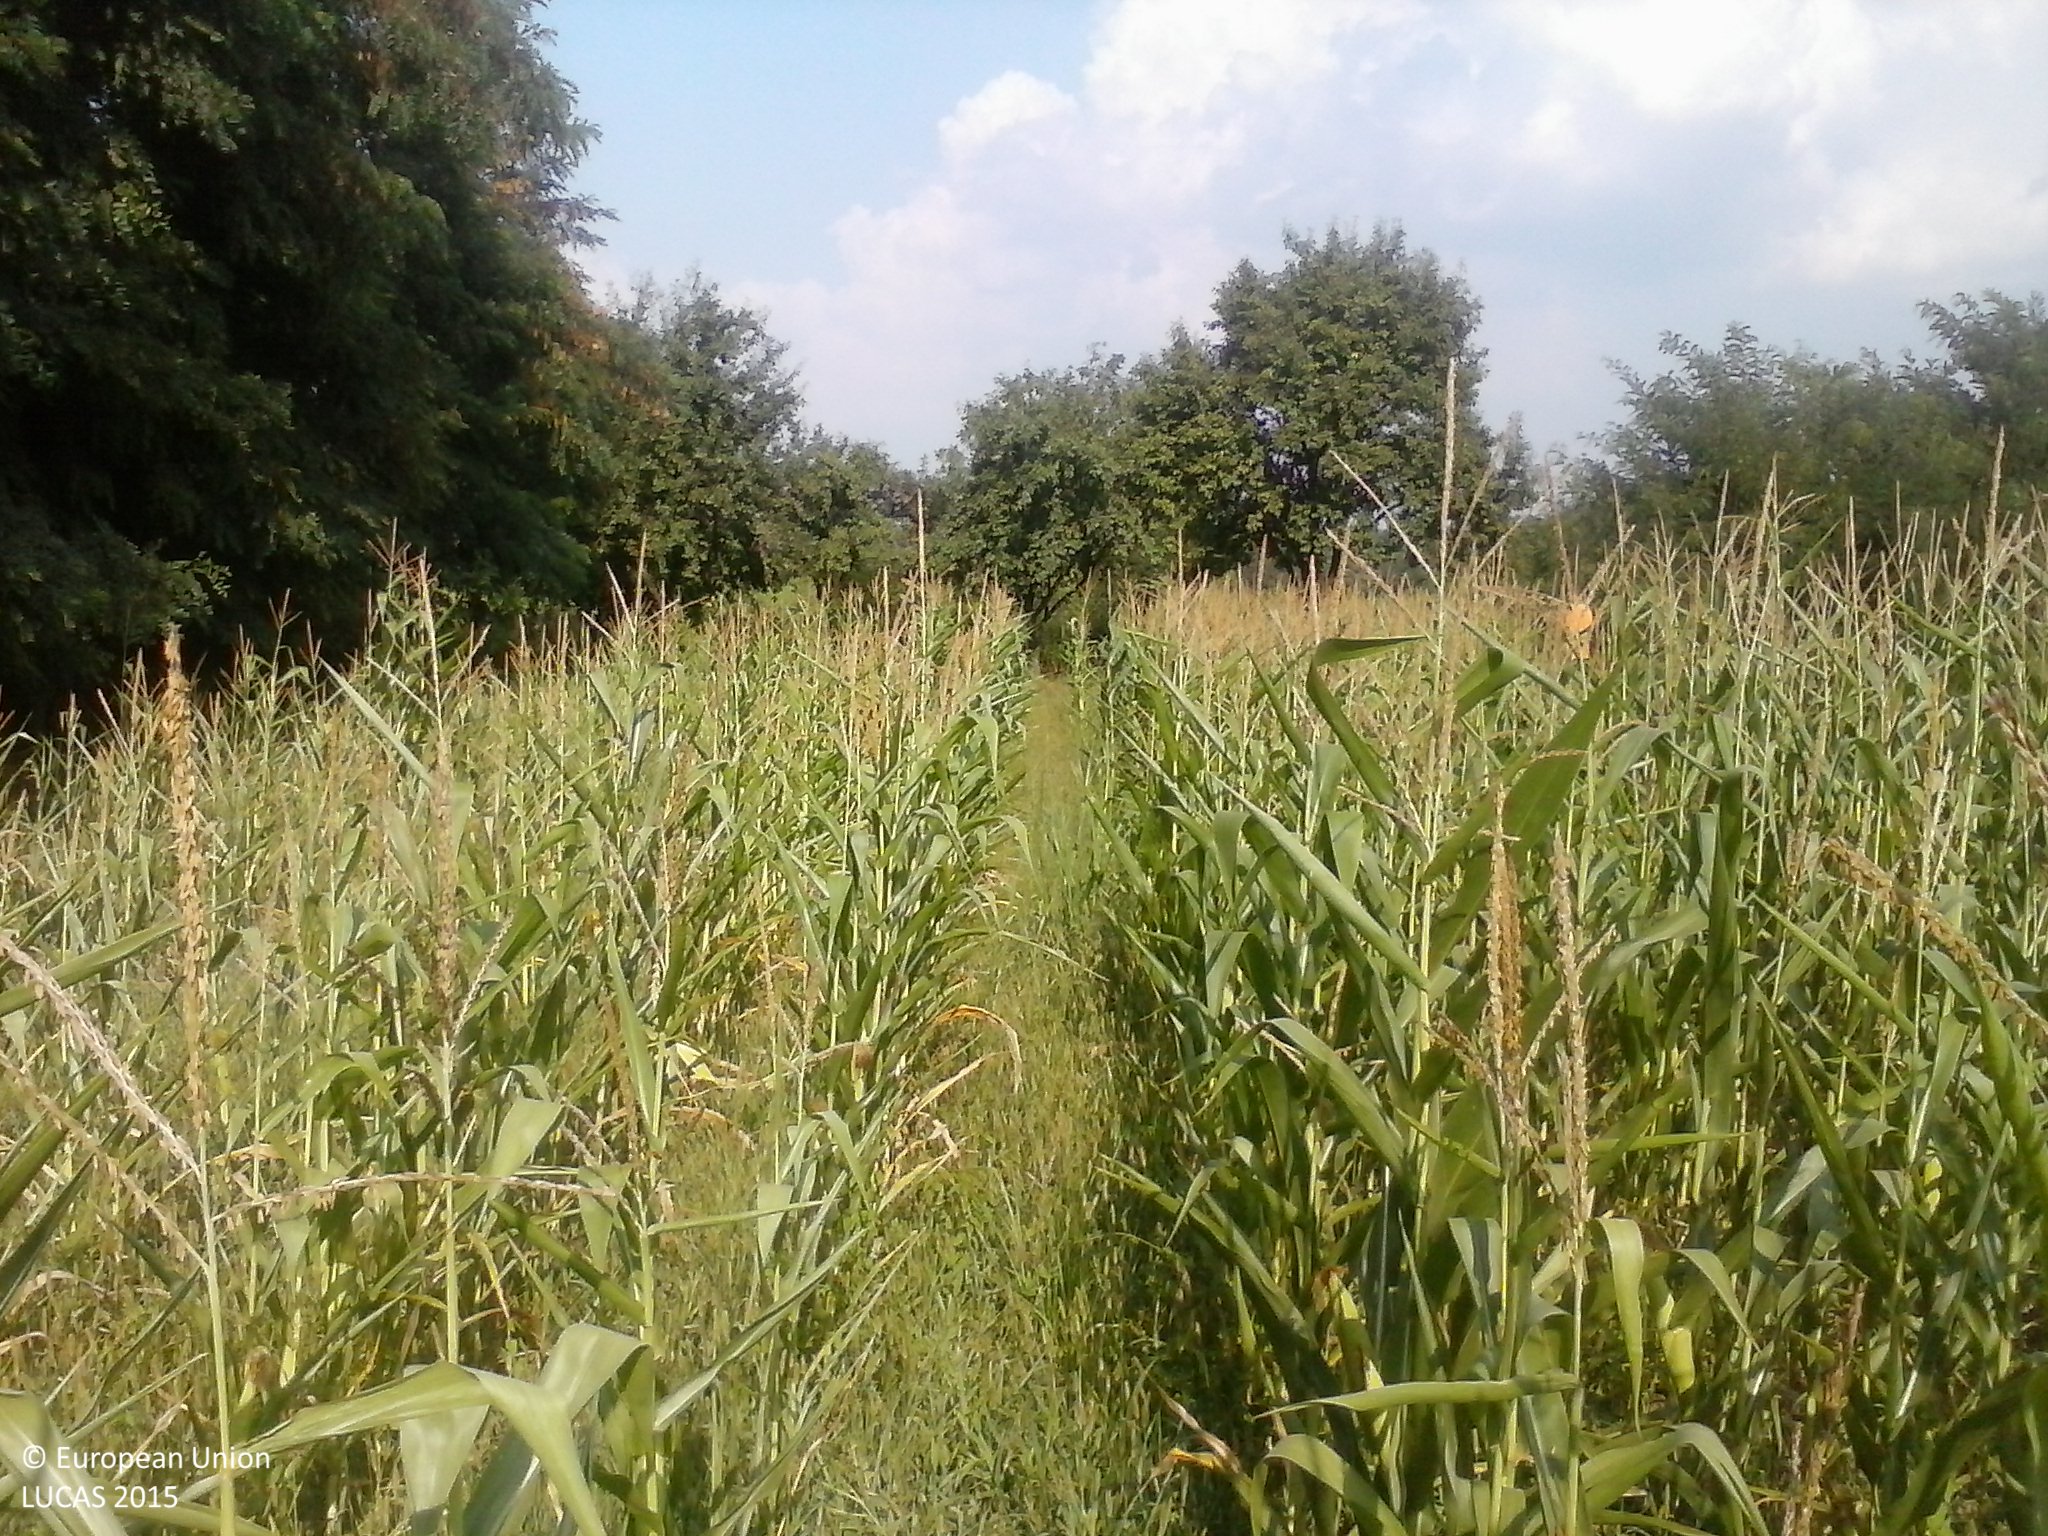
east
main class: Cropland
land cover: Maize
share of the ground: > 75 %
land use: Agriculture (excluding fallow land and kitchen gardens)
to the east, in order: Maize; Grass margins; Tracks; Grass margins; Broadleaved woodland; Maize; Abandoned hedges; Tracks; Abandoned hedges; Other bare soil
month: August
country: HU
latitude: 46.0859
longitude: 17.7772
